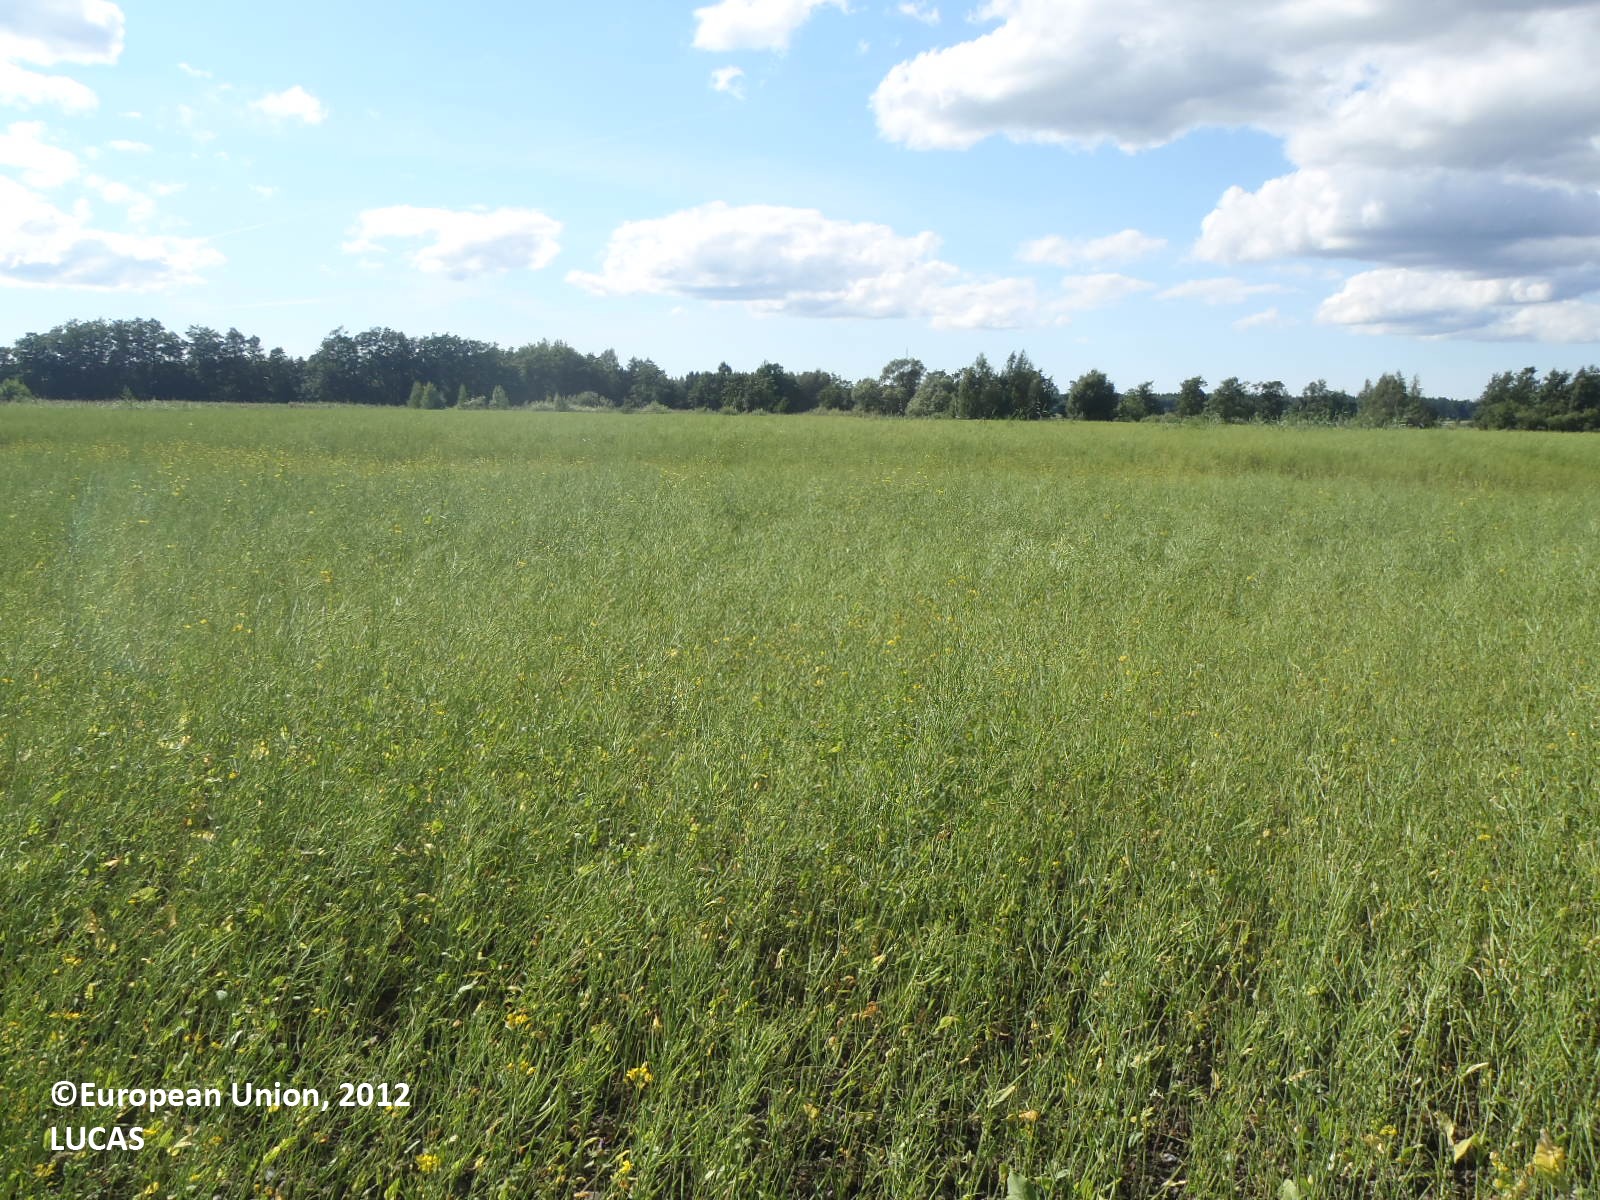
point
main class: Cropland
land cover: Rape and turnip rape
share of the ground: > 75 %
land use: Agriculture (excluding fallow land and kitchen gardens)
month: July
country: FI
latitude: 60.6452
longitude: 21.8556
